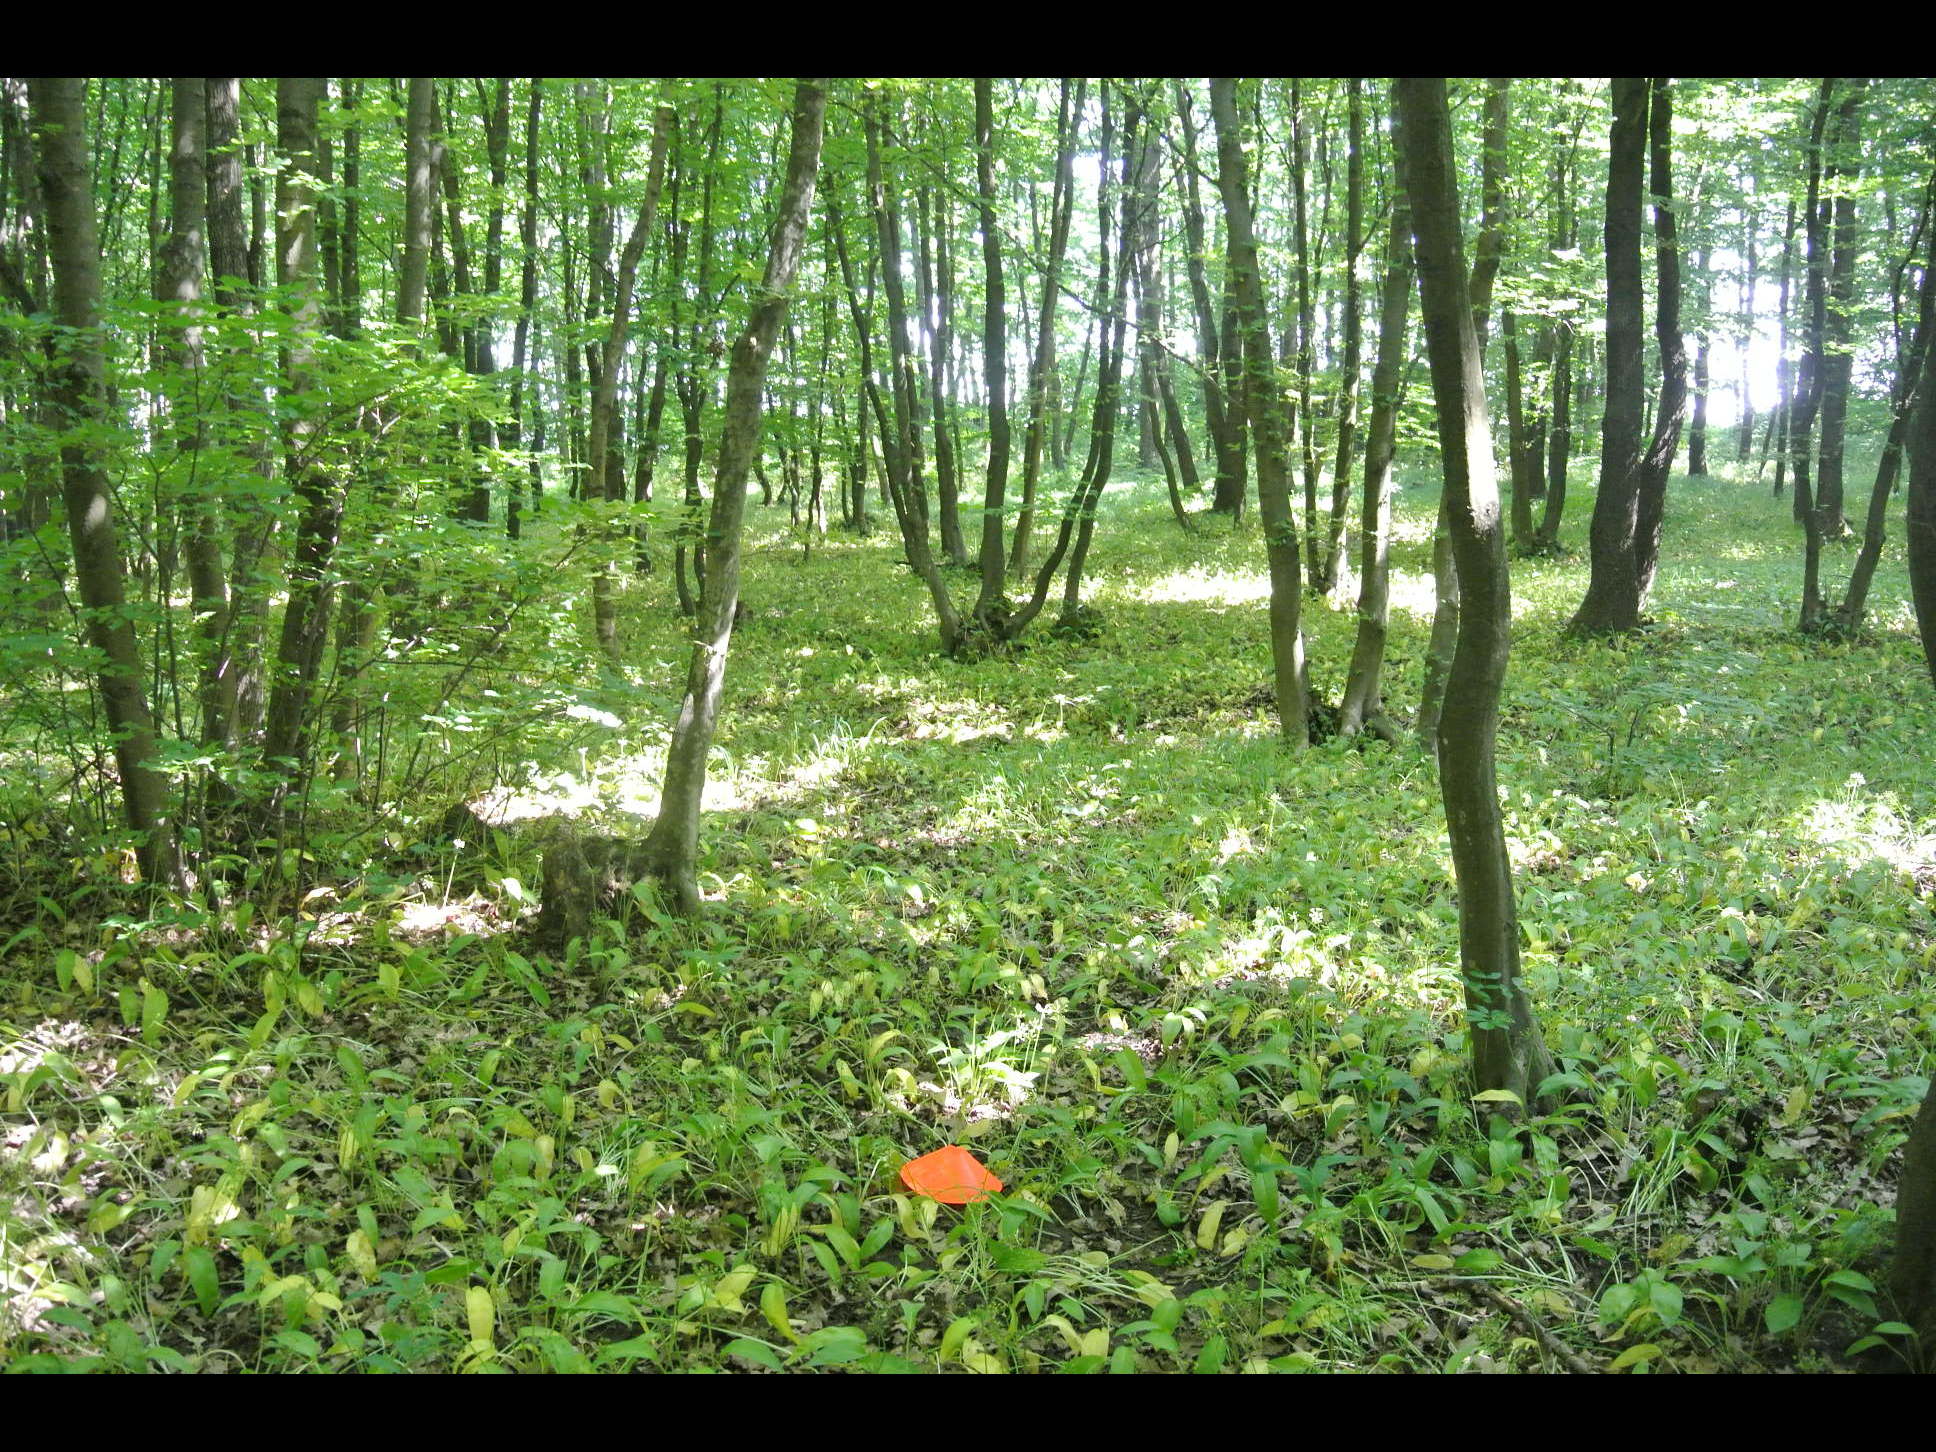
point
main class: Woodland
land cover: Broadleaved woodland
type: mesophytic deciduous forest
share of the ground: > 75 %
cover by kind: broadleaved forest trees 100 %
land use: Forestry
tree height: > 5 m
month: June
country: AT
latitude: 47.9057
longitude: 16.4932
